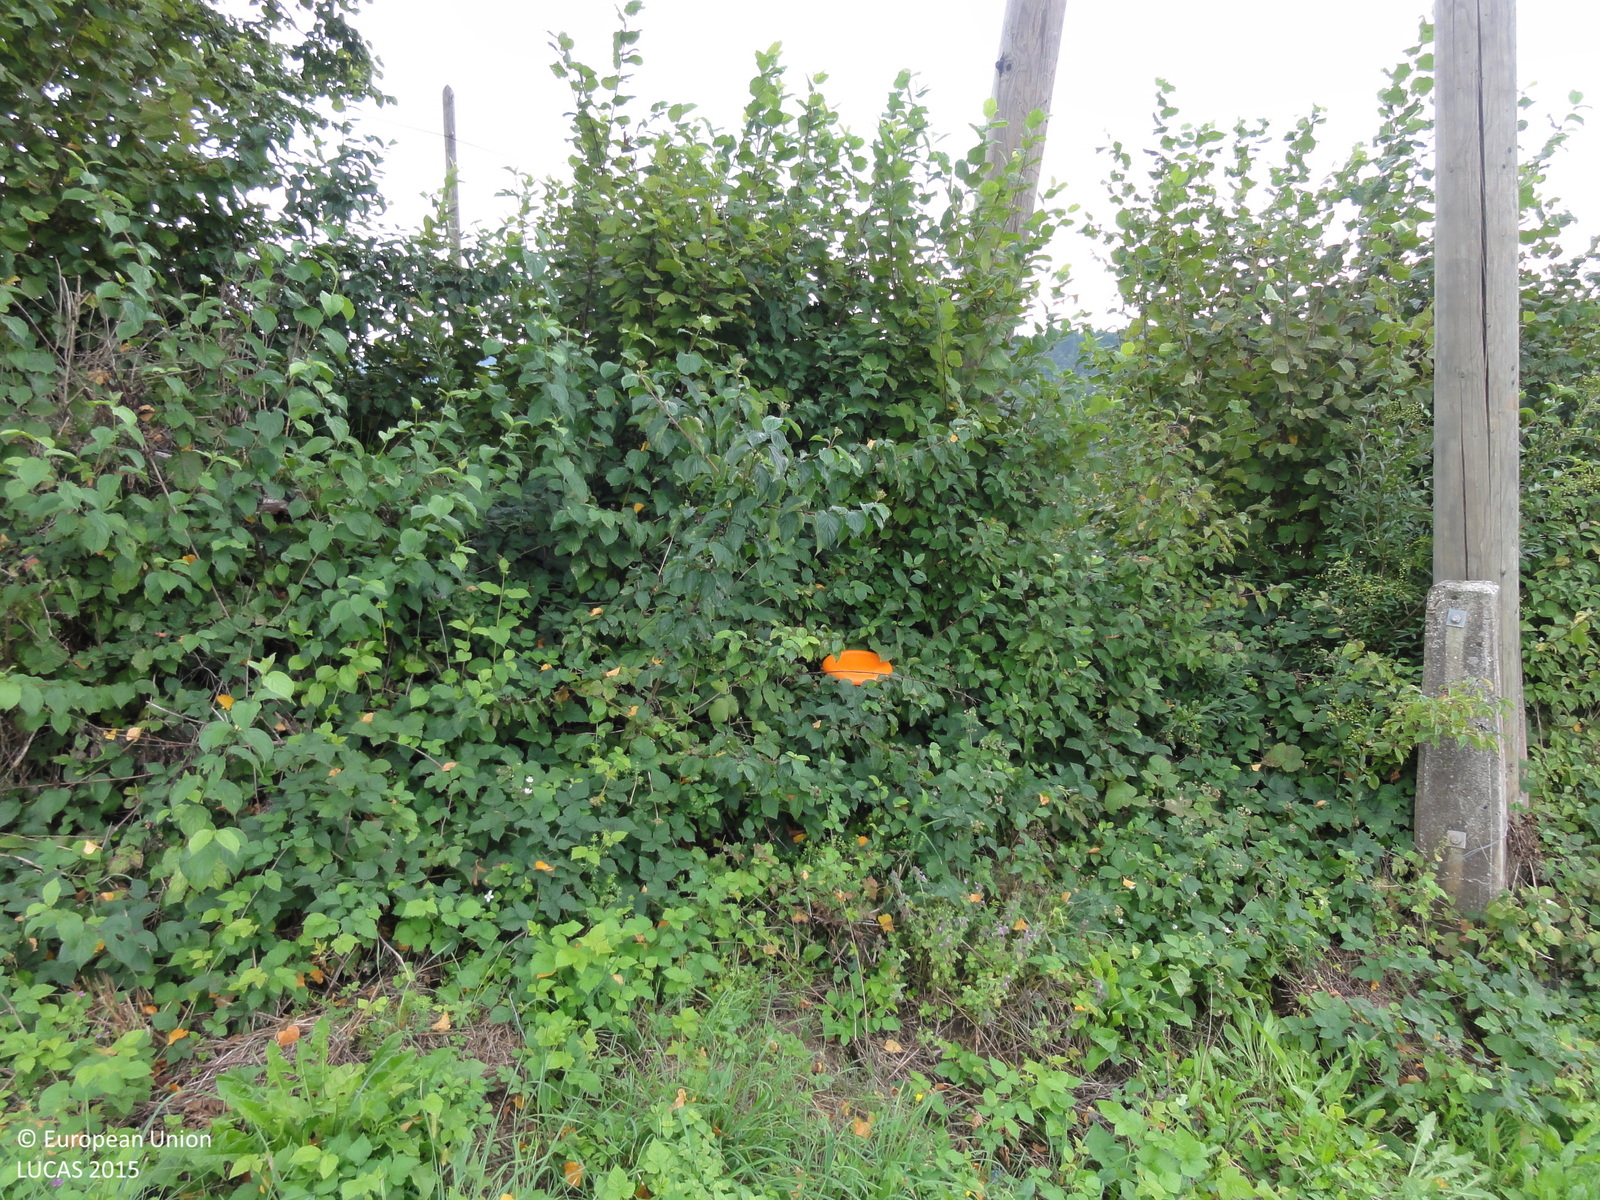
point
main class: Artificial land
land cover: Other artificial areas
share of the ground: < 10 %
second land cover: Shrubland with sparse tree cover
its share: > 75 %
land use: Electricity, gas and thermal power distribution
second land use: Agriculture (excluding fallow land and kitchen gardens)
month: August
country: SI
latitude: 46.1150
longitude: 14.8491
